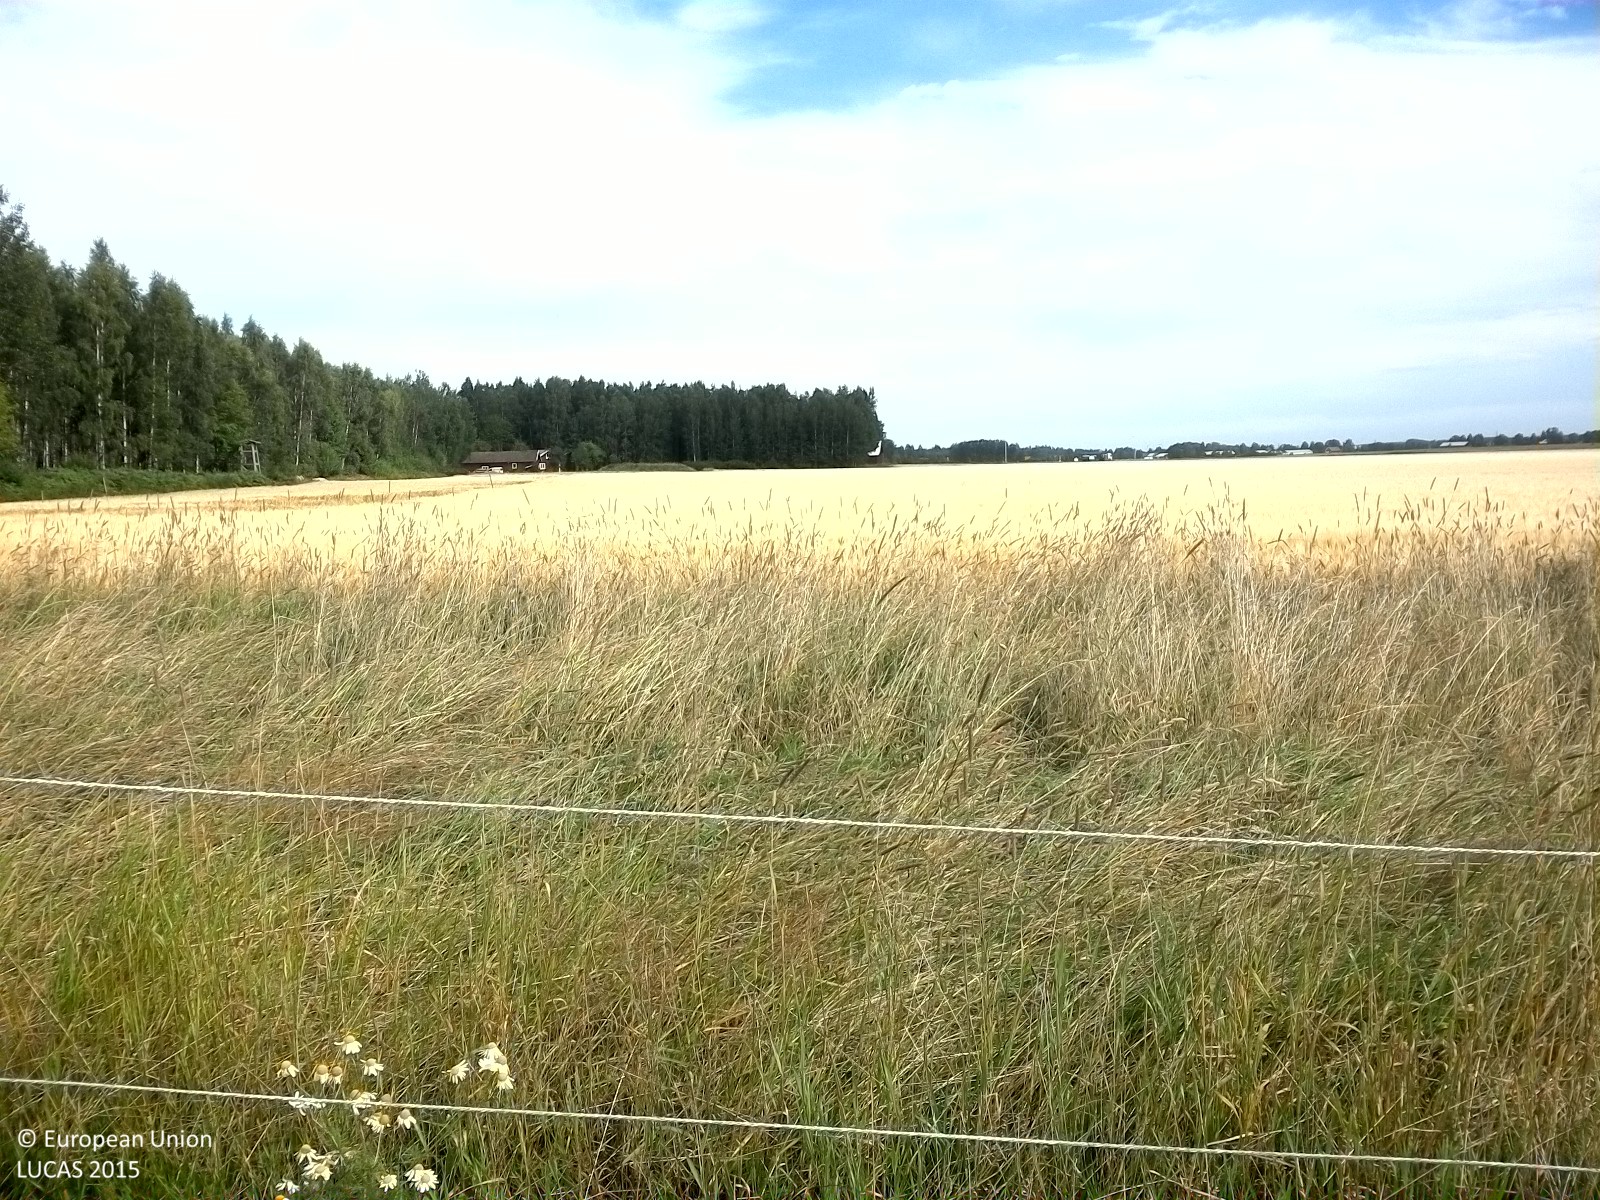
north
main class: Grassland
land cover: Grassland without tree/shrub cover
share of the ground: > 75 %
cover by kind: herbaceous plants 100 %
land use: Agriculture (excluding fallow land and kitchen gardens)
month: August
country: SE
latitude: 59.0975
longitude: 15.0720
